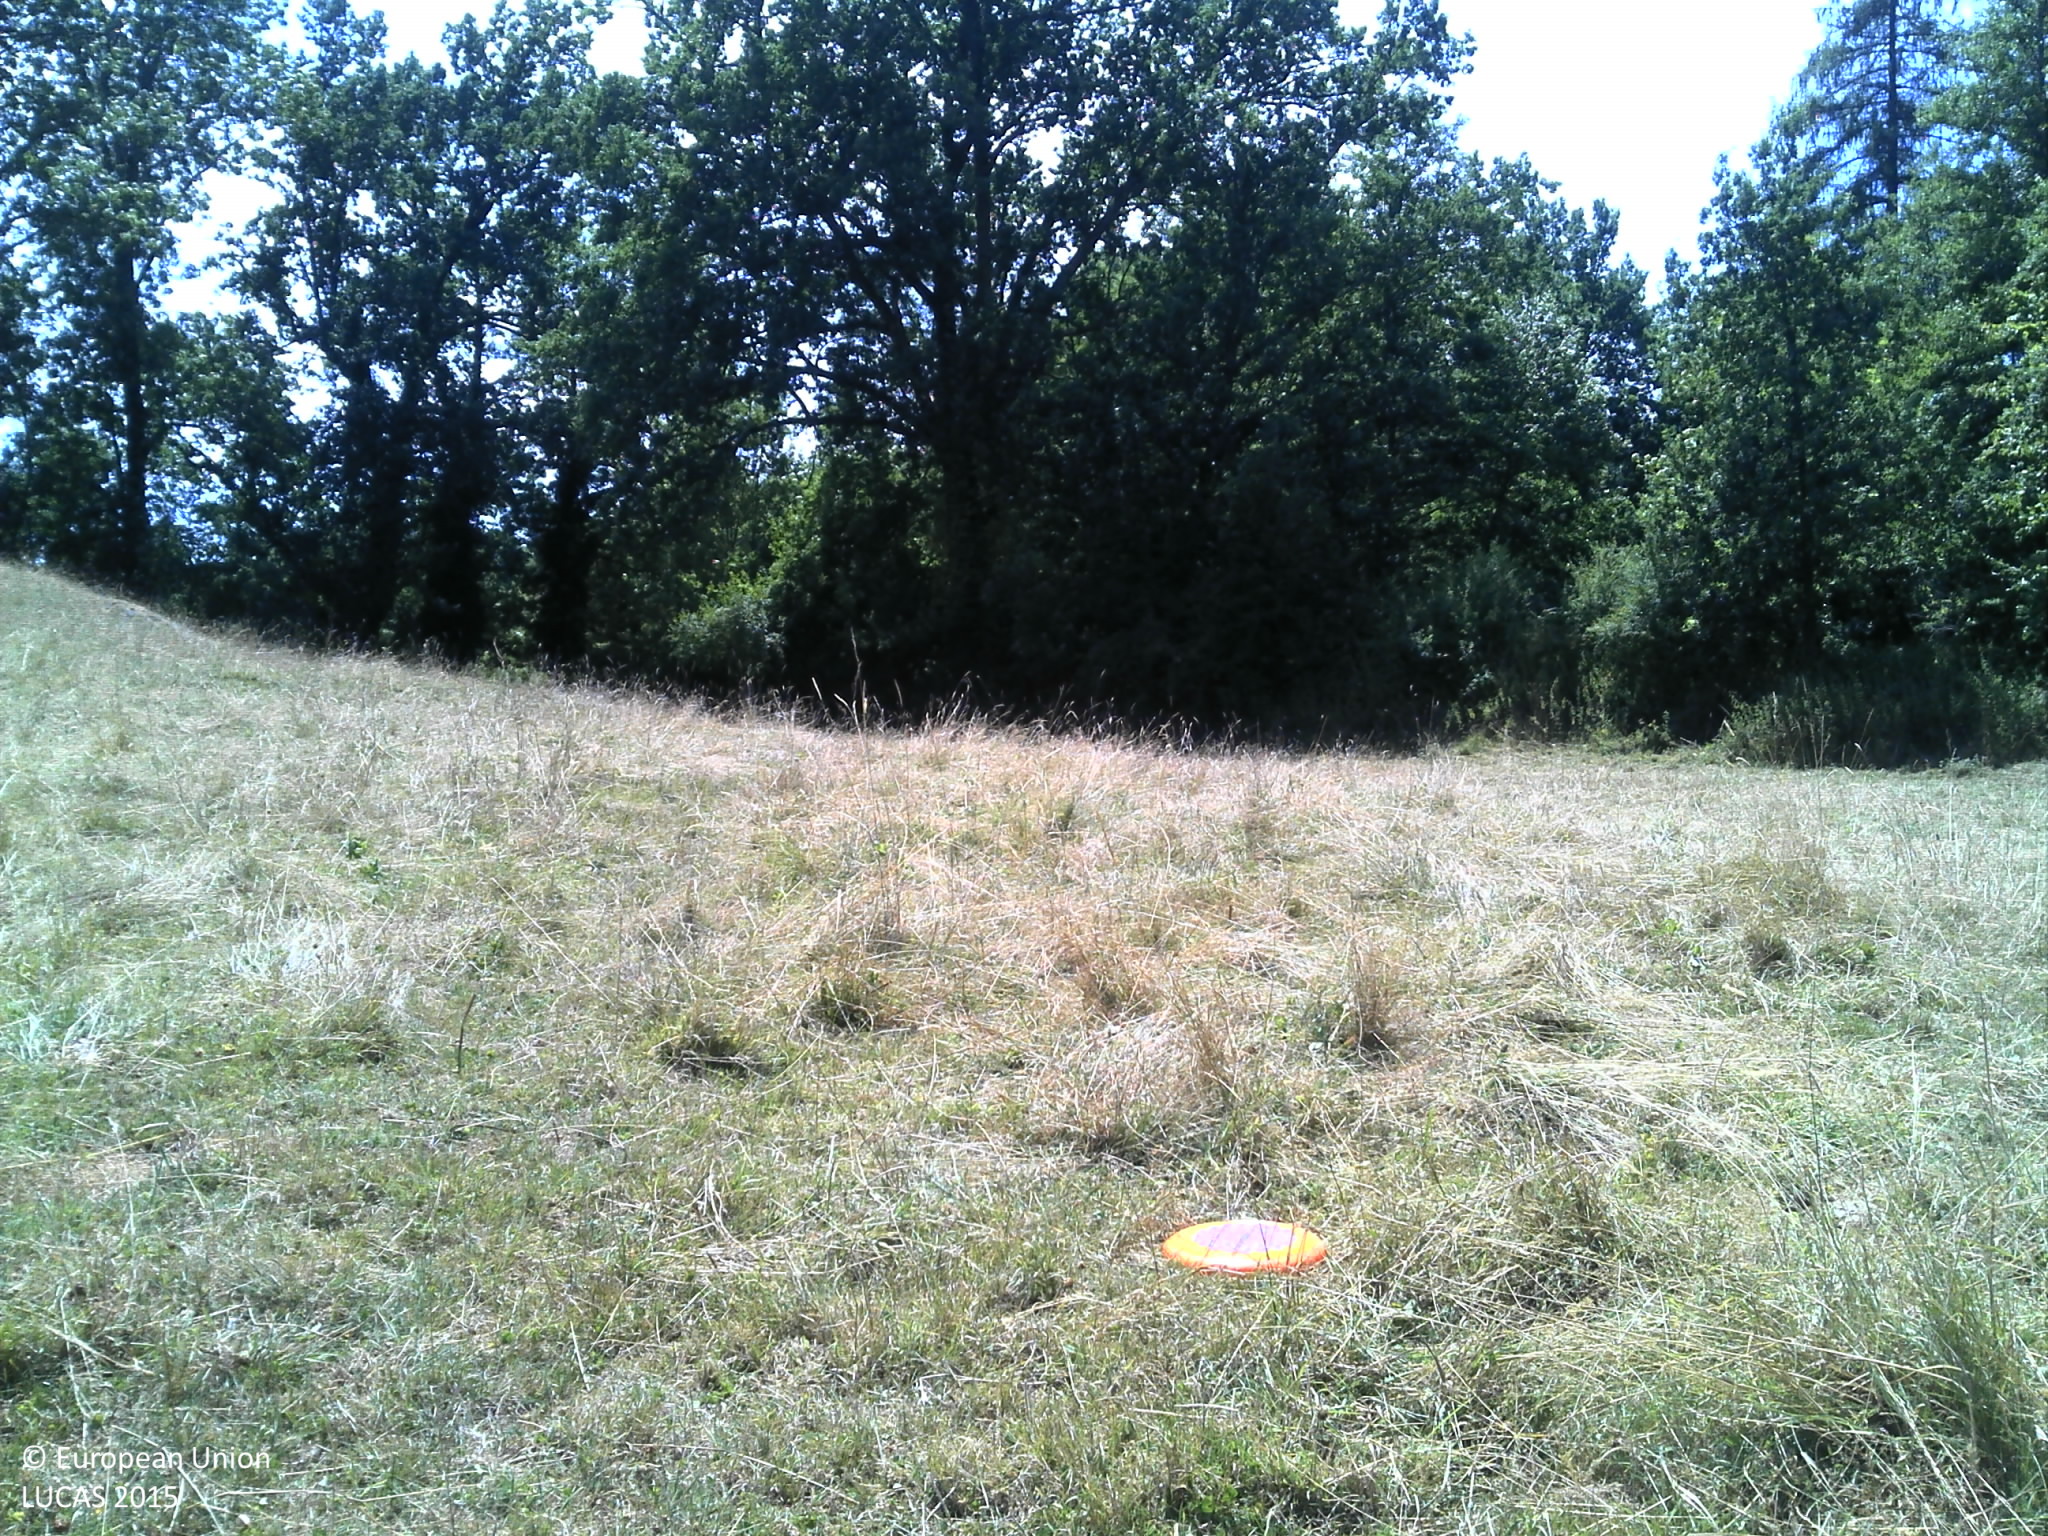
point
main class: Grassland
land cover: Grassland without tree/shrub cover
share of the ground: > 75 %
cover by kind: herbaceous plants 100 %
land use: Agriculture (excluding fallow land and kitchen gardens)
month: July
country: FR
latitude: 45.4263
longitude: 3.7271
